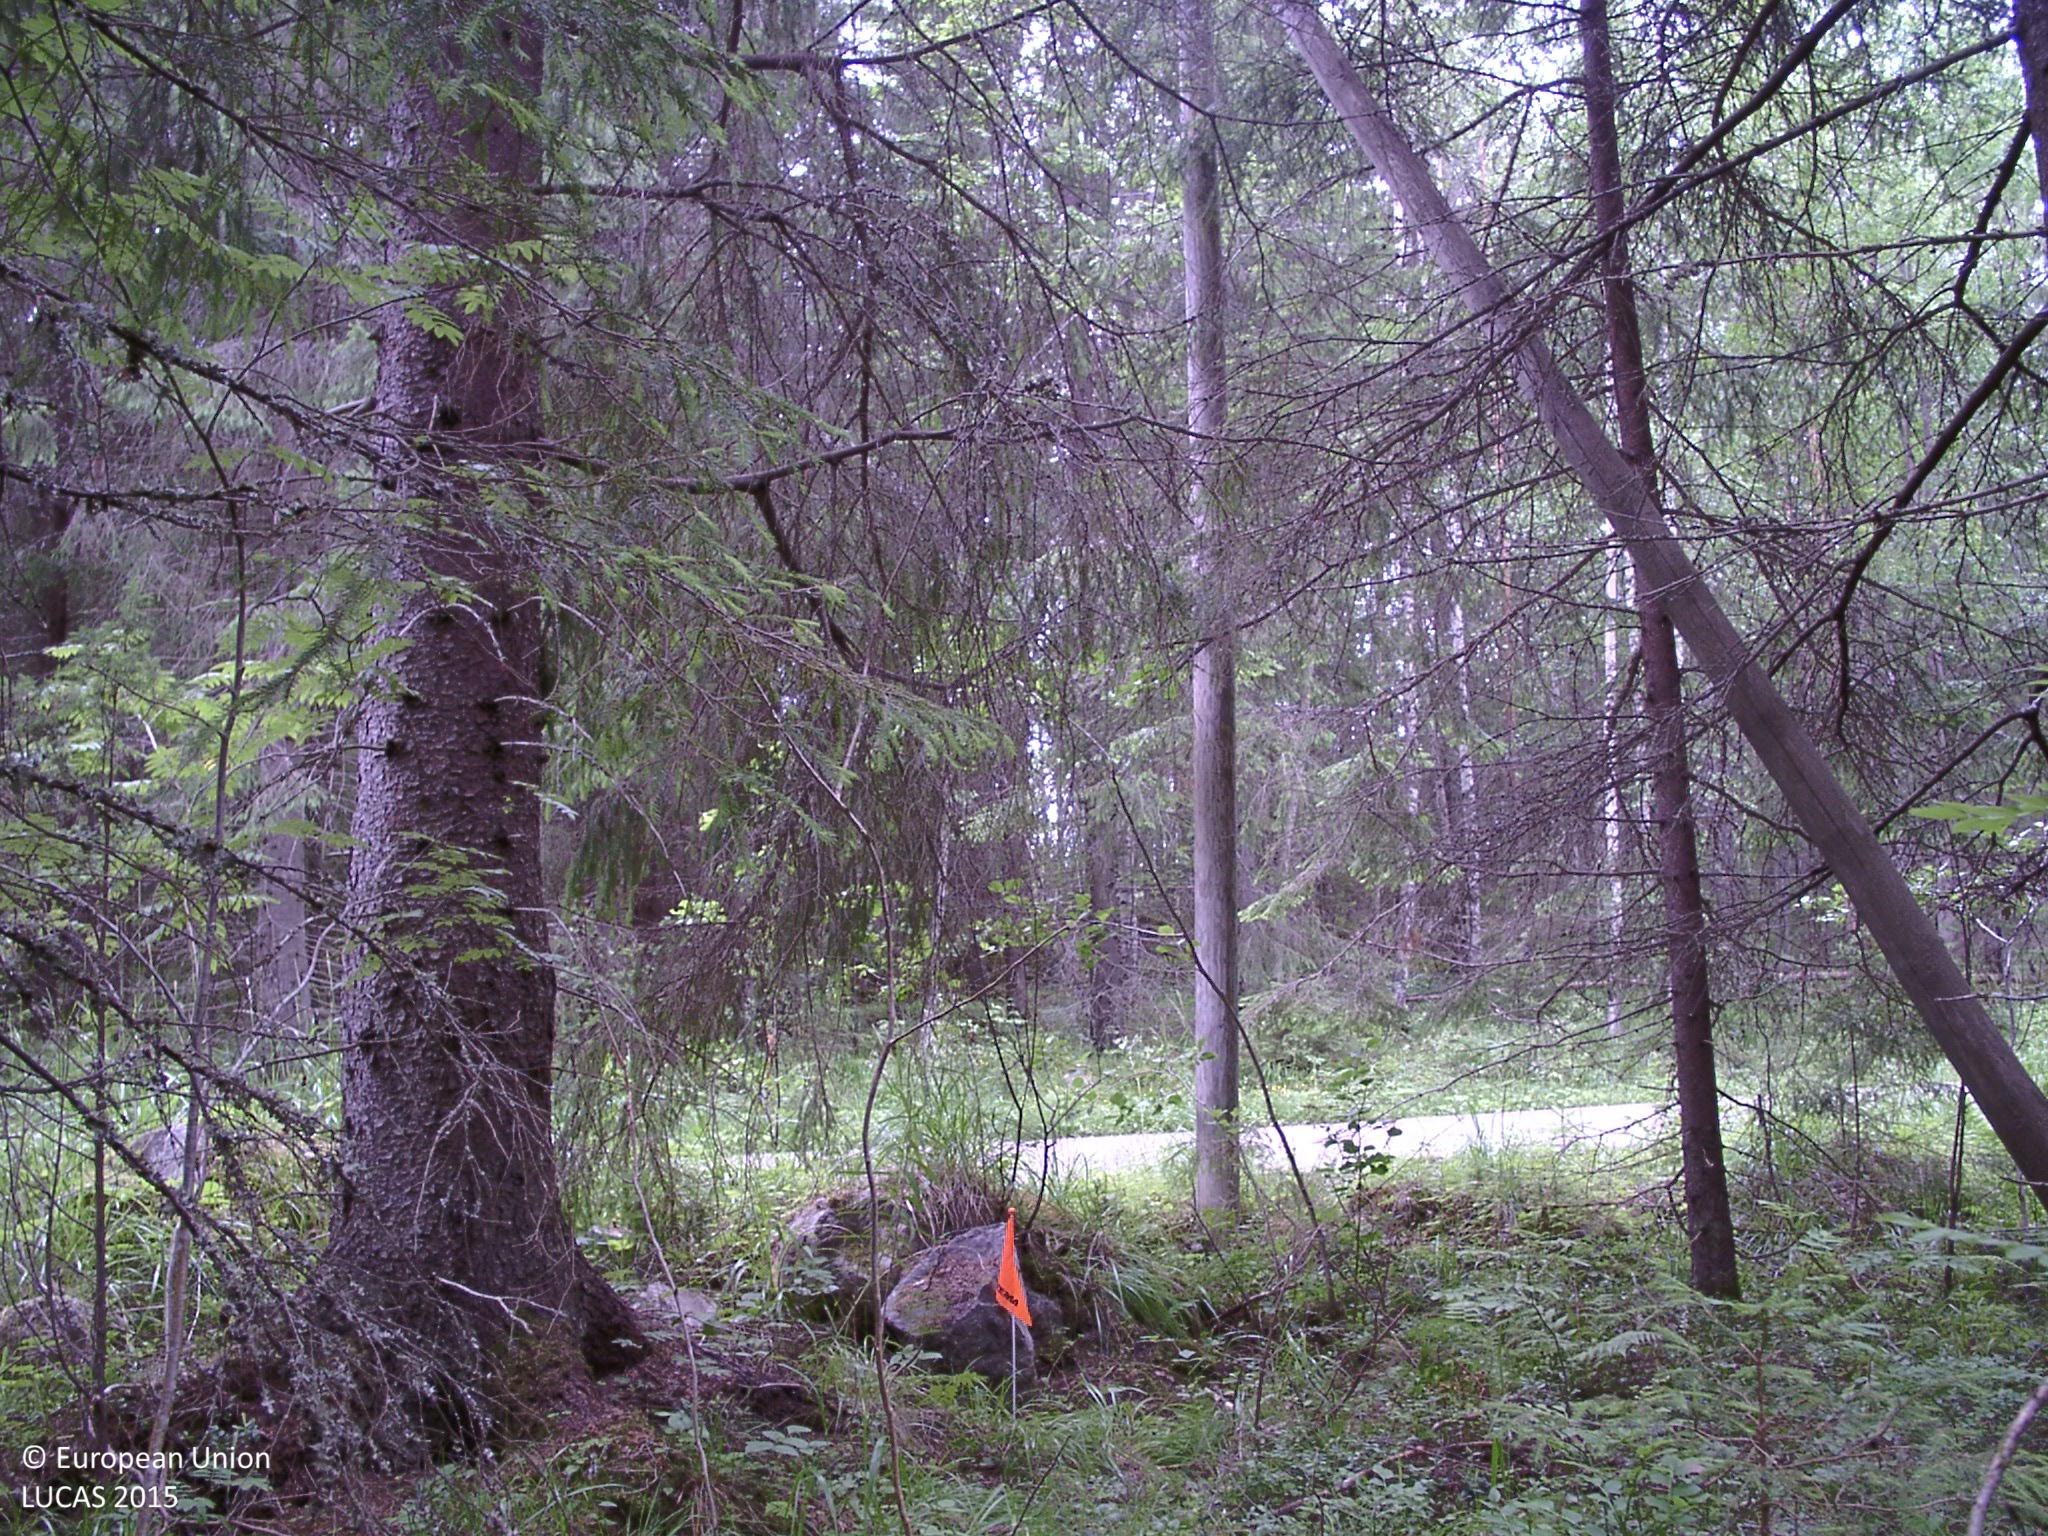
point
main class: Woodland
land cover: Spruce dominated coniferous woodland
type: boreal forest
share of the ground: 50 - 75 %
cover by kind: coniferous forest trees 55 %, broadleaved forest trees 15 %, herbaceous plants 15 %, shrubs 10 %, lichens and mosses 5 %
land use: Semi-natural and natural areas not in use
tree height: > 5 m
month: July
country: FI
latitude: 61.6813
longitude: 25.2498
